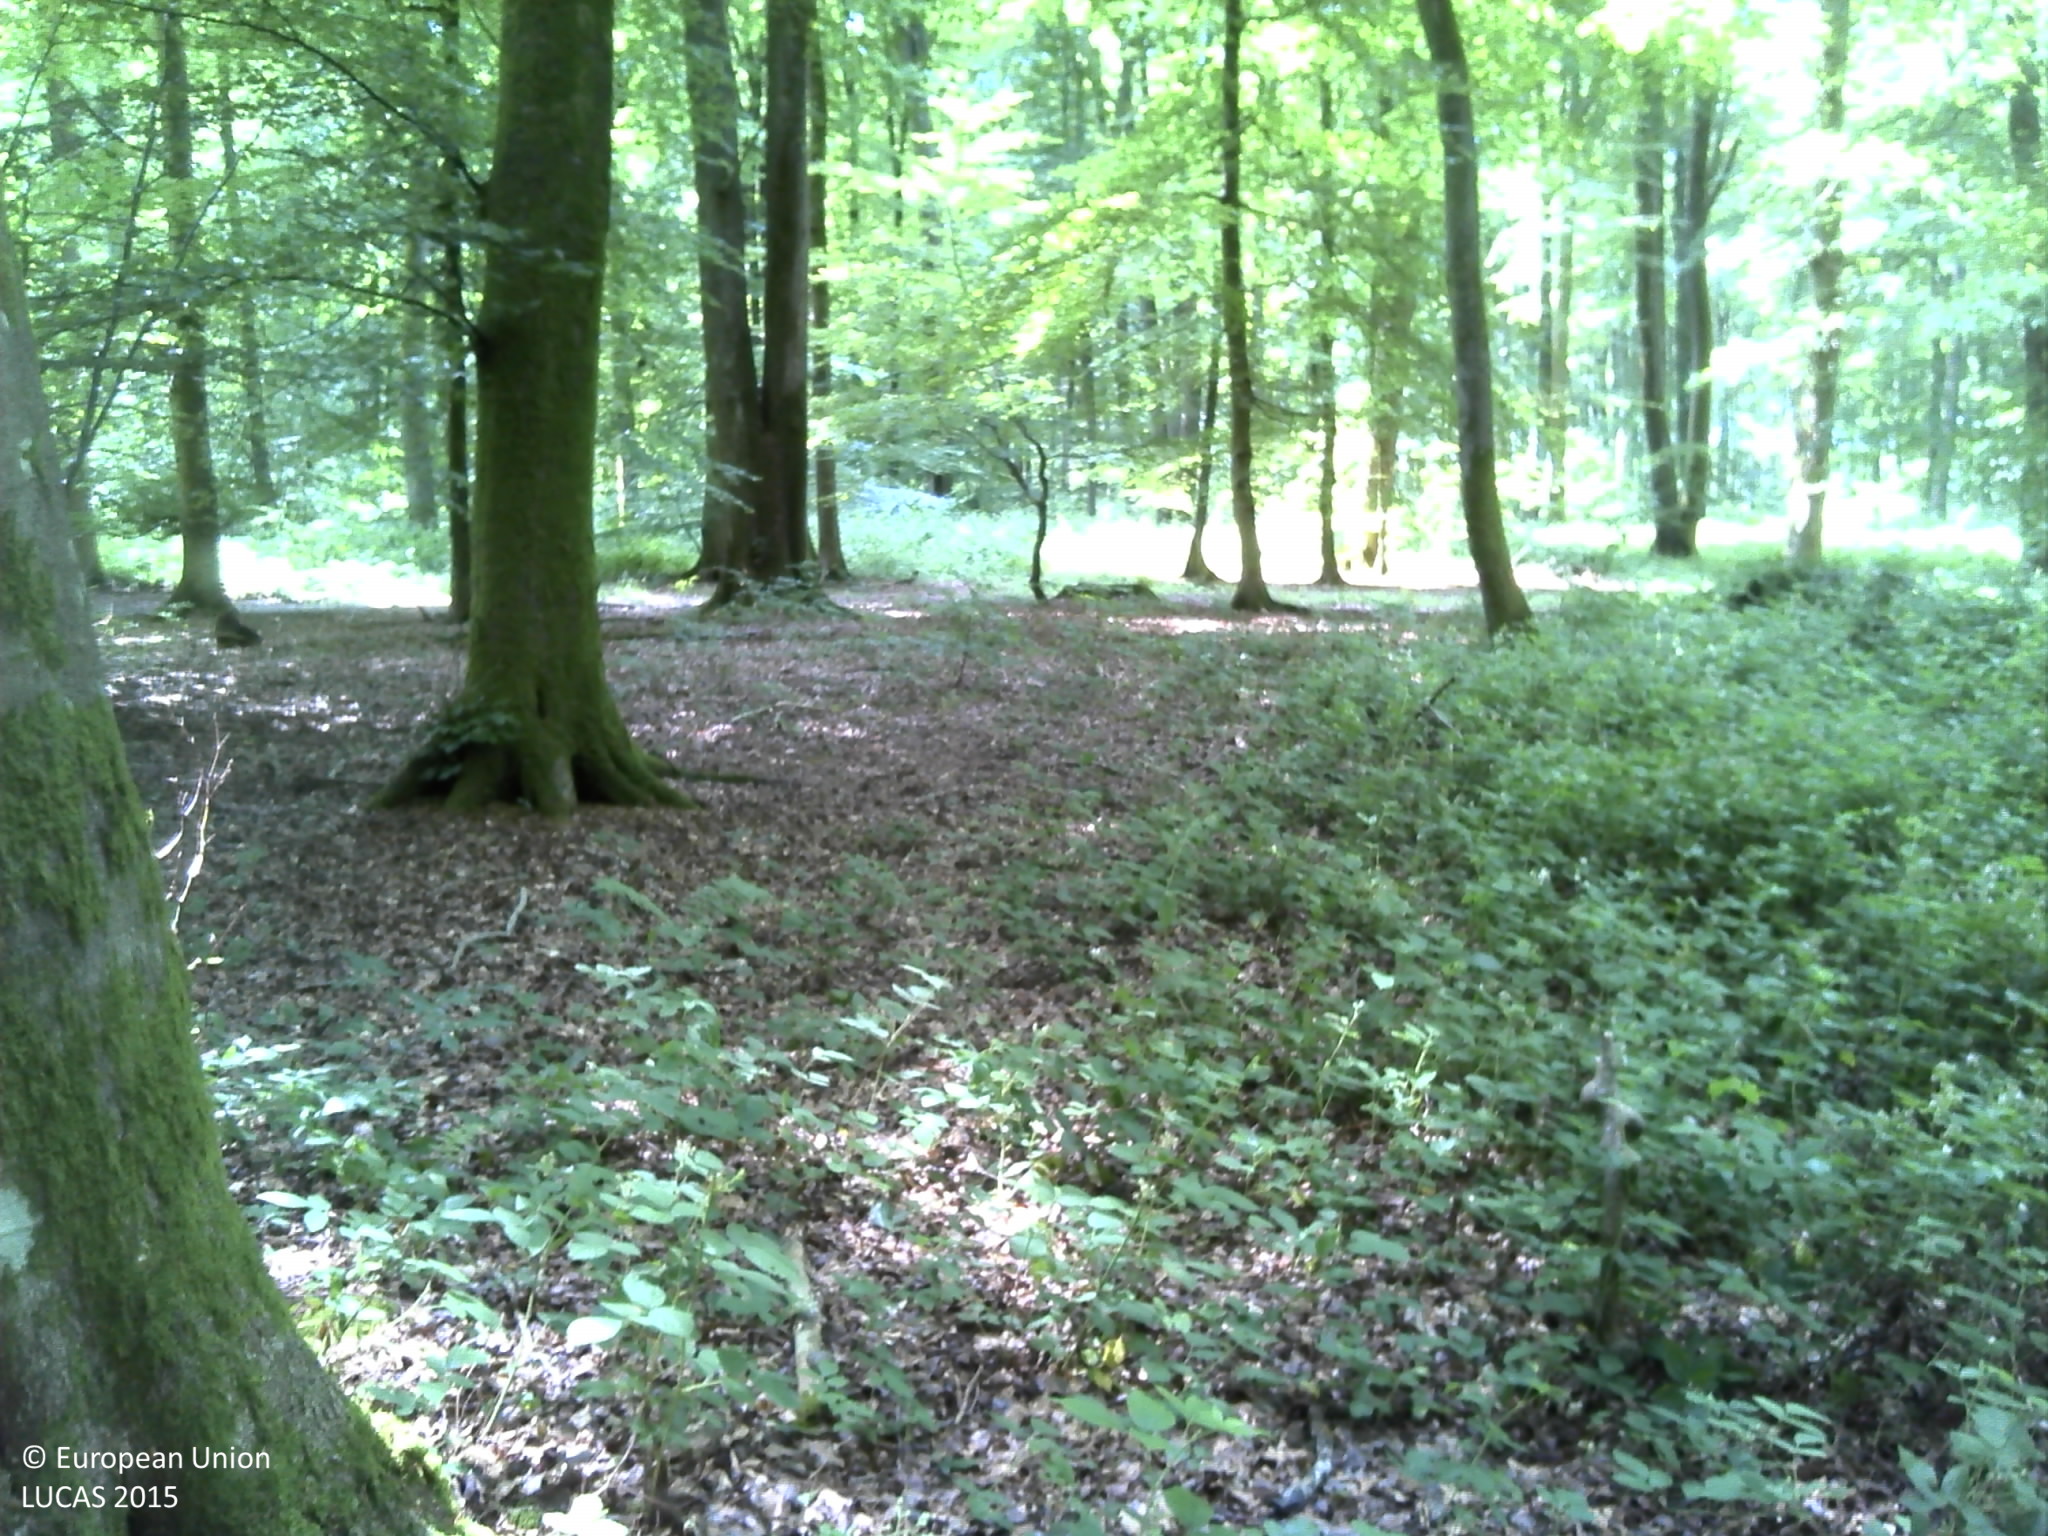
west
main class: Woodland
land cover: Broadleaved woodland
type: beech forest
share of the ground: > 75 %
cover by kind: broadleaved forest trees 100 %
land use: Forestry
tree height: > 5 m
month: July
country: FR
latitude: 49.8931
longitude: 1.6160
